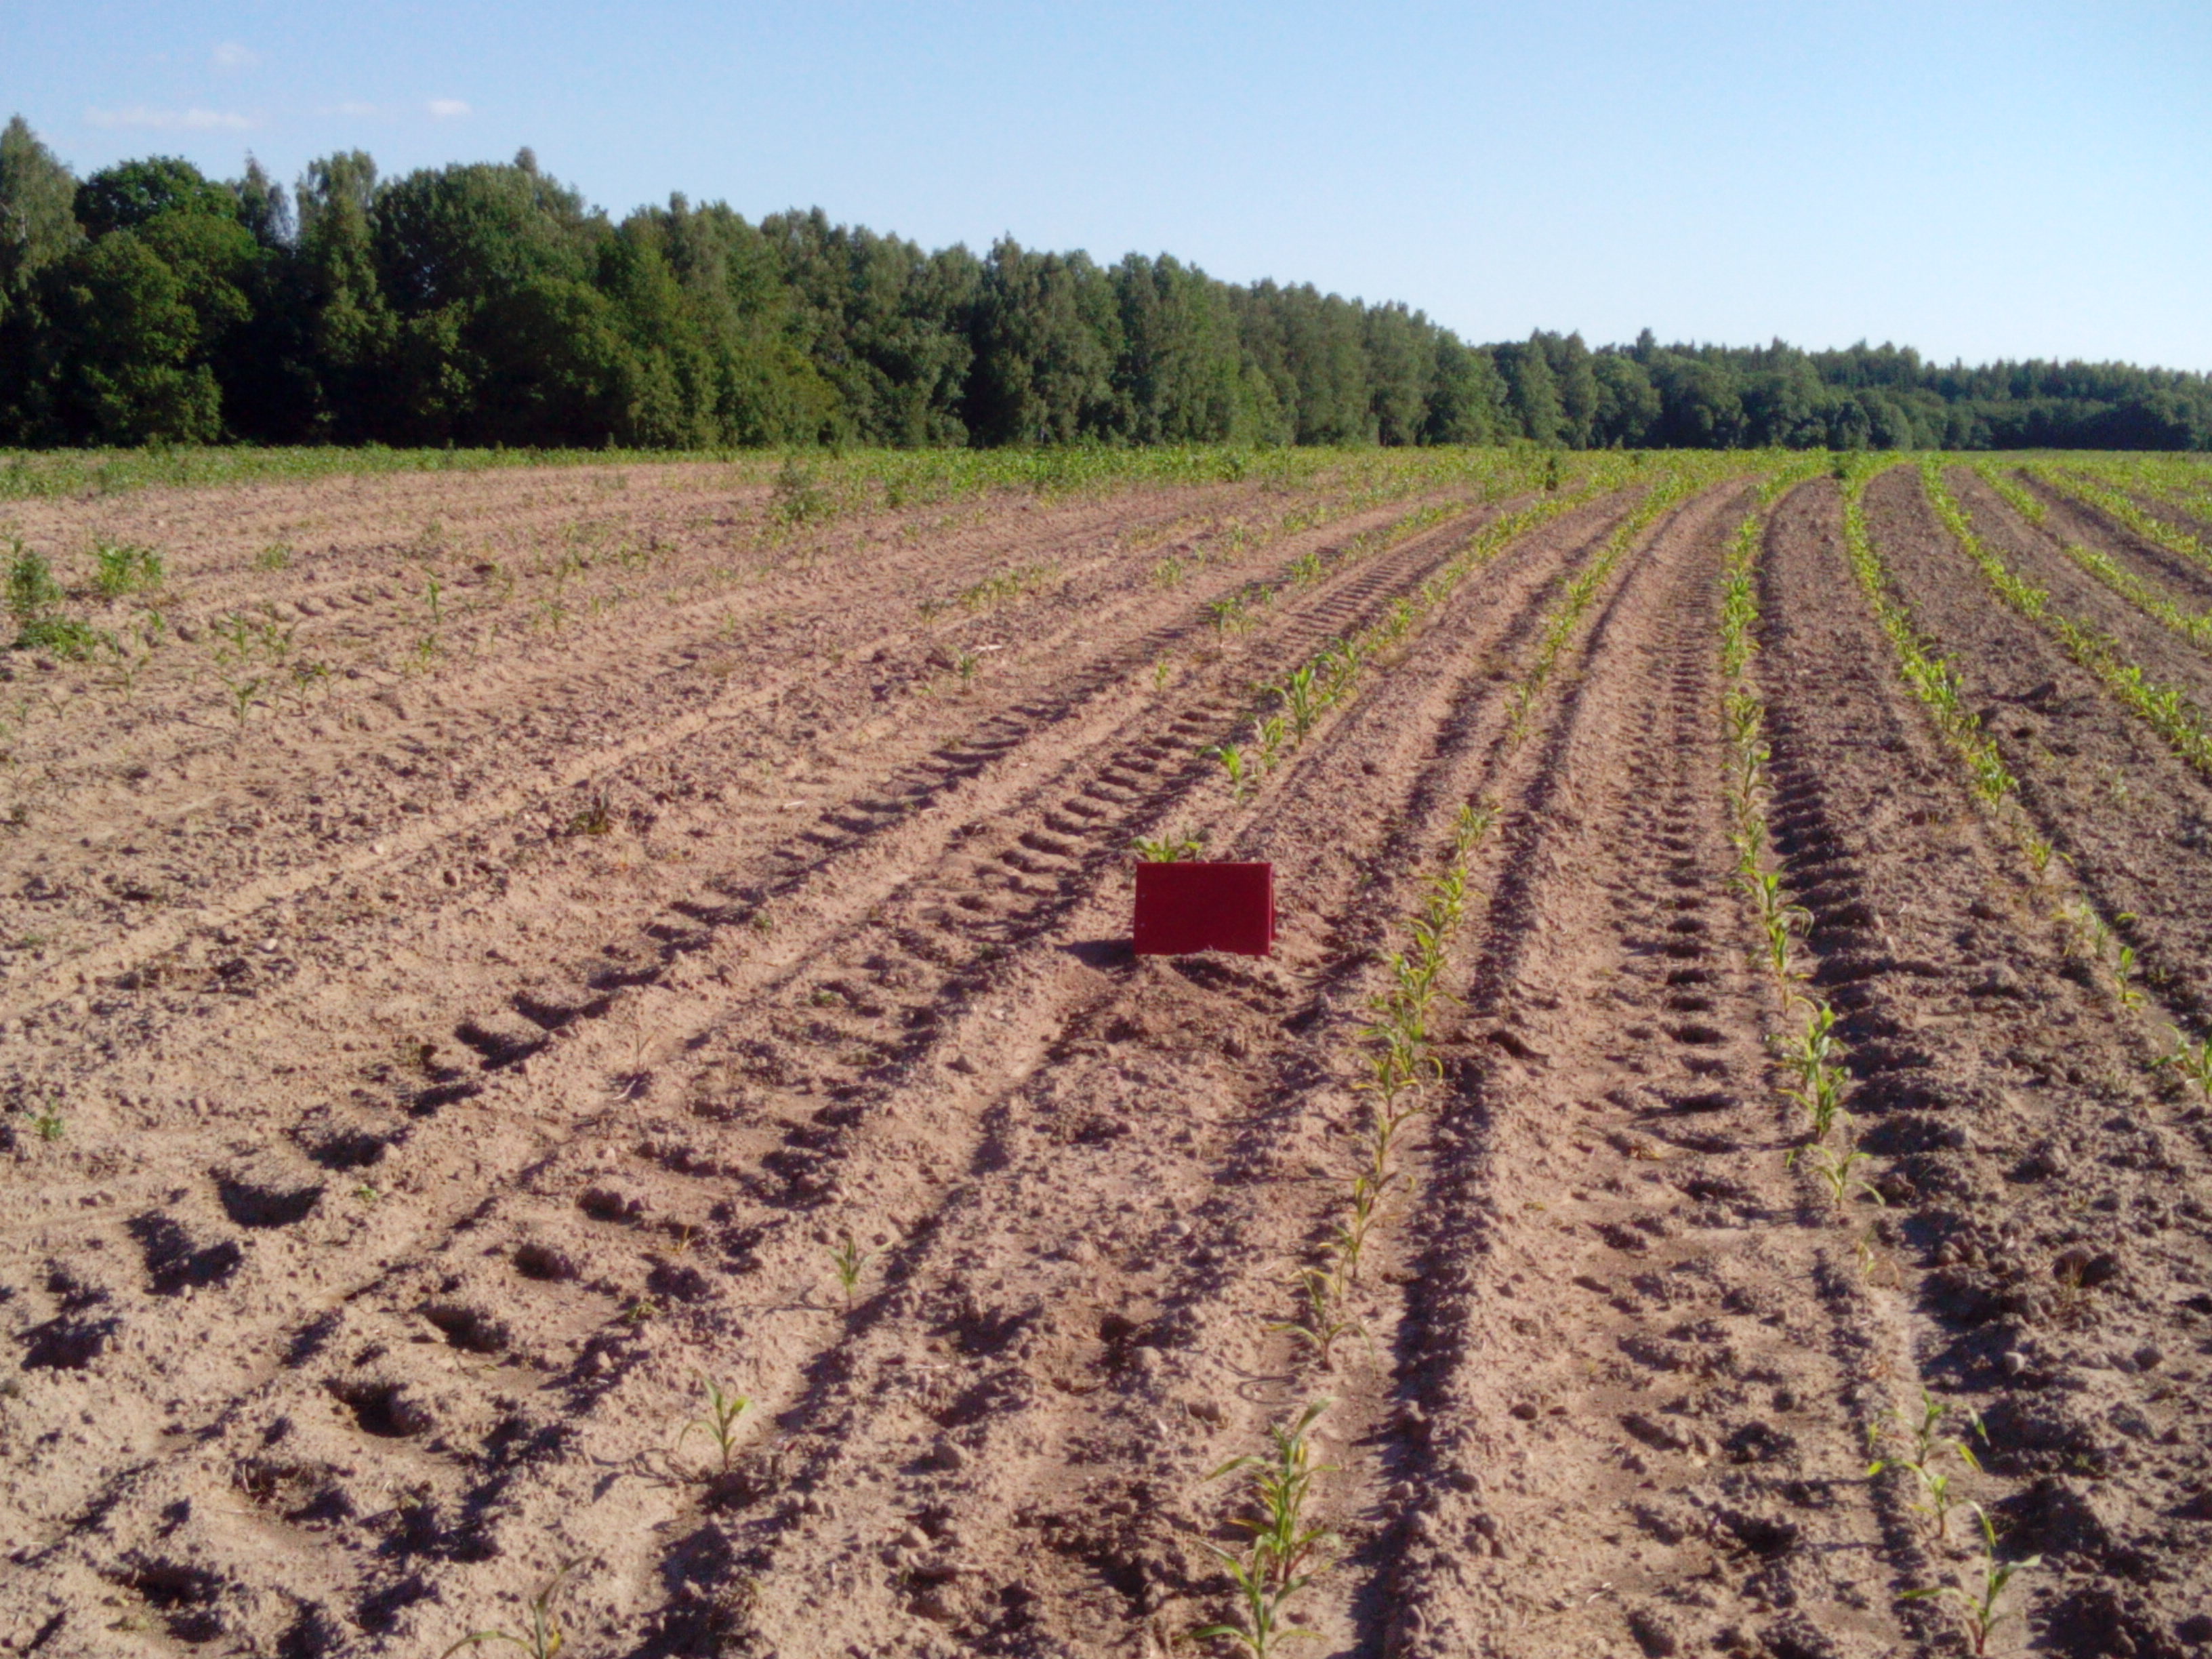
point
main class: Cropland
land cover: Maize
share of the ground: 10 - 25 %
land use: Agriculture (excluding fallow land and kitchen gardens)
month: July
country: LV
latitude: 56.4381
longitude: 21.8384
